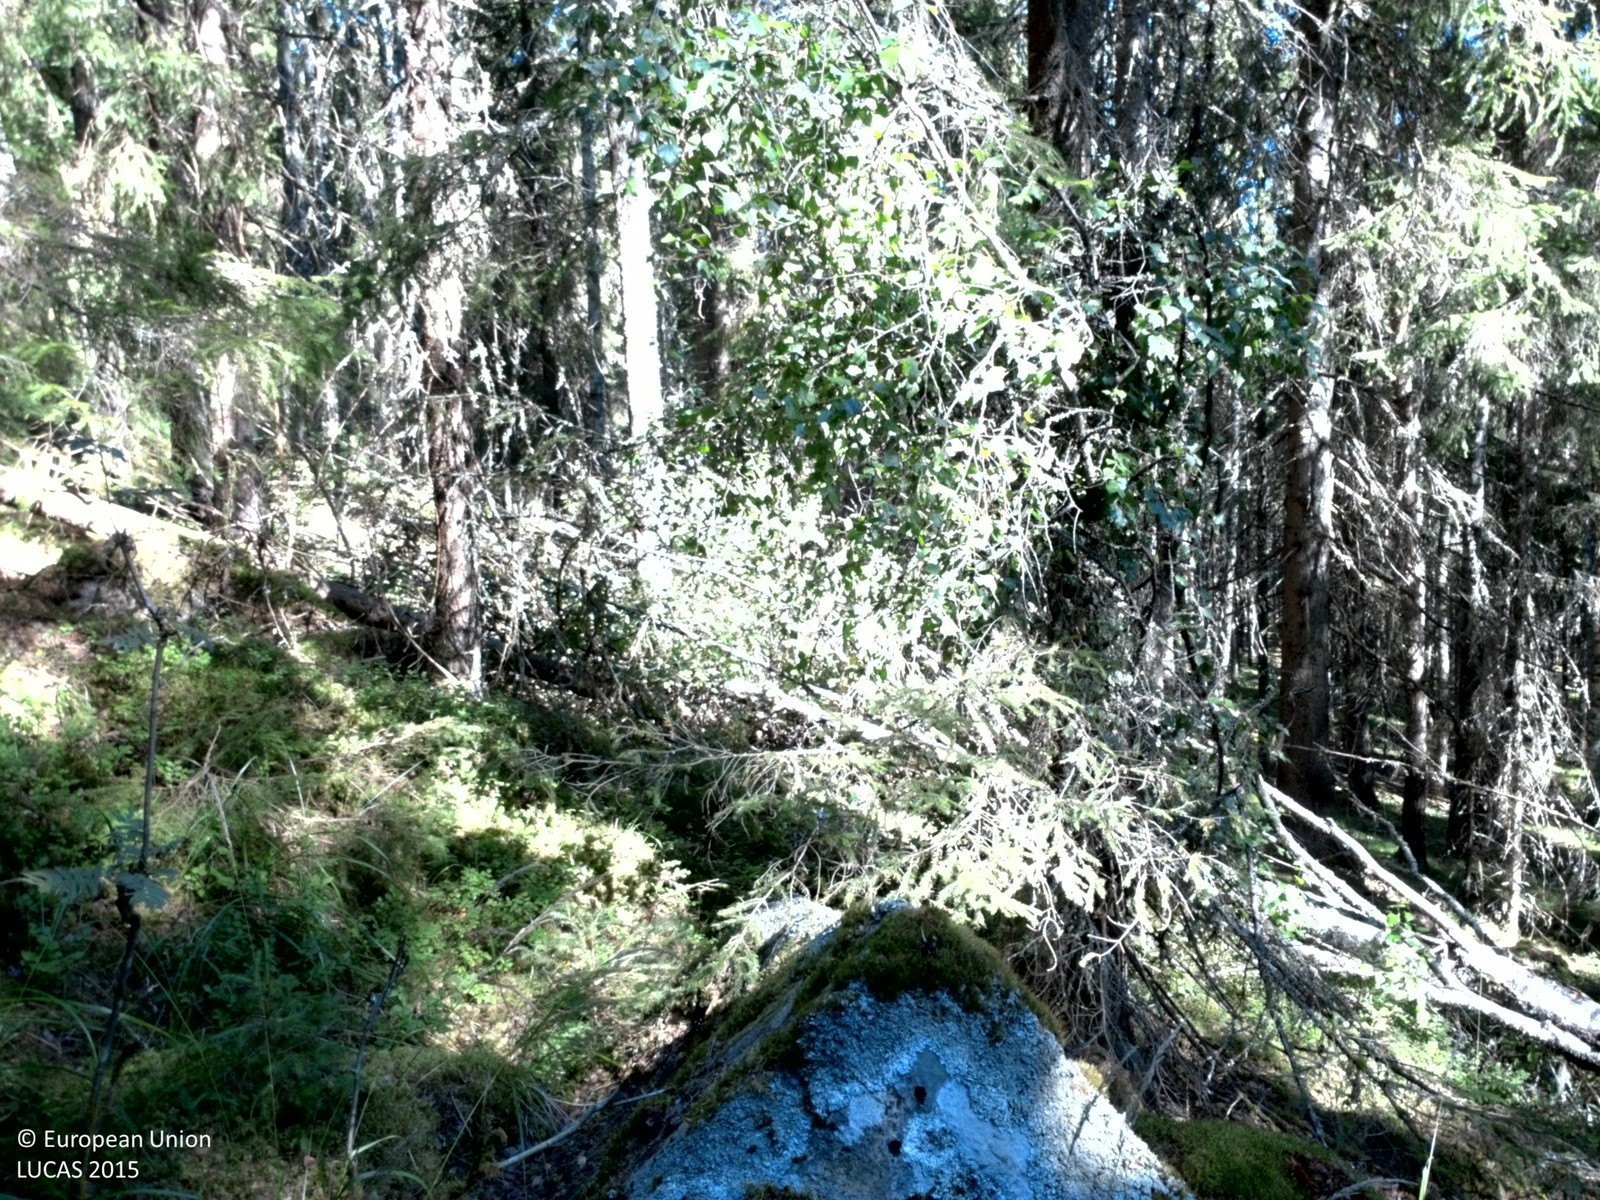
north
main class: Woodland
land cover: Spruce dominated coniferous woodland
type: boreal forest
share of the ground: 50 - 75 %
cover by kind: coniferous forest trees 65 %, lichens and mosses 15 %, shrubs 10 %, broadleaved forest trees 5 %, herbaceous plants 5 %
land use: Forestry
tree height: > 5 m
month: August
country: SE
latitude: 59.9079
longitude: 13.2993
